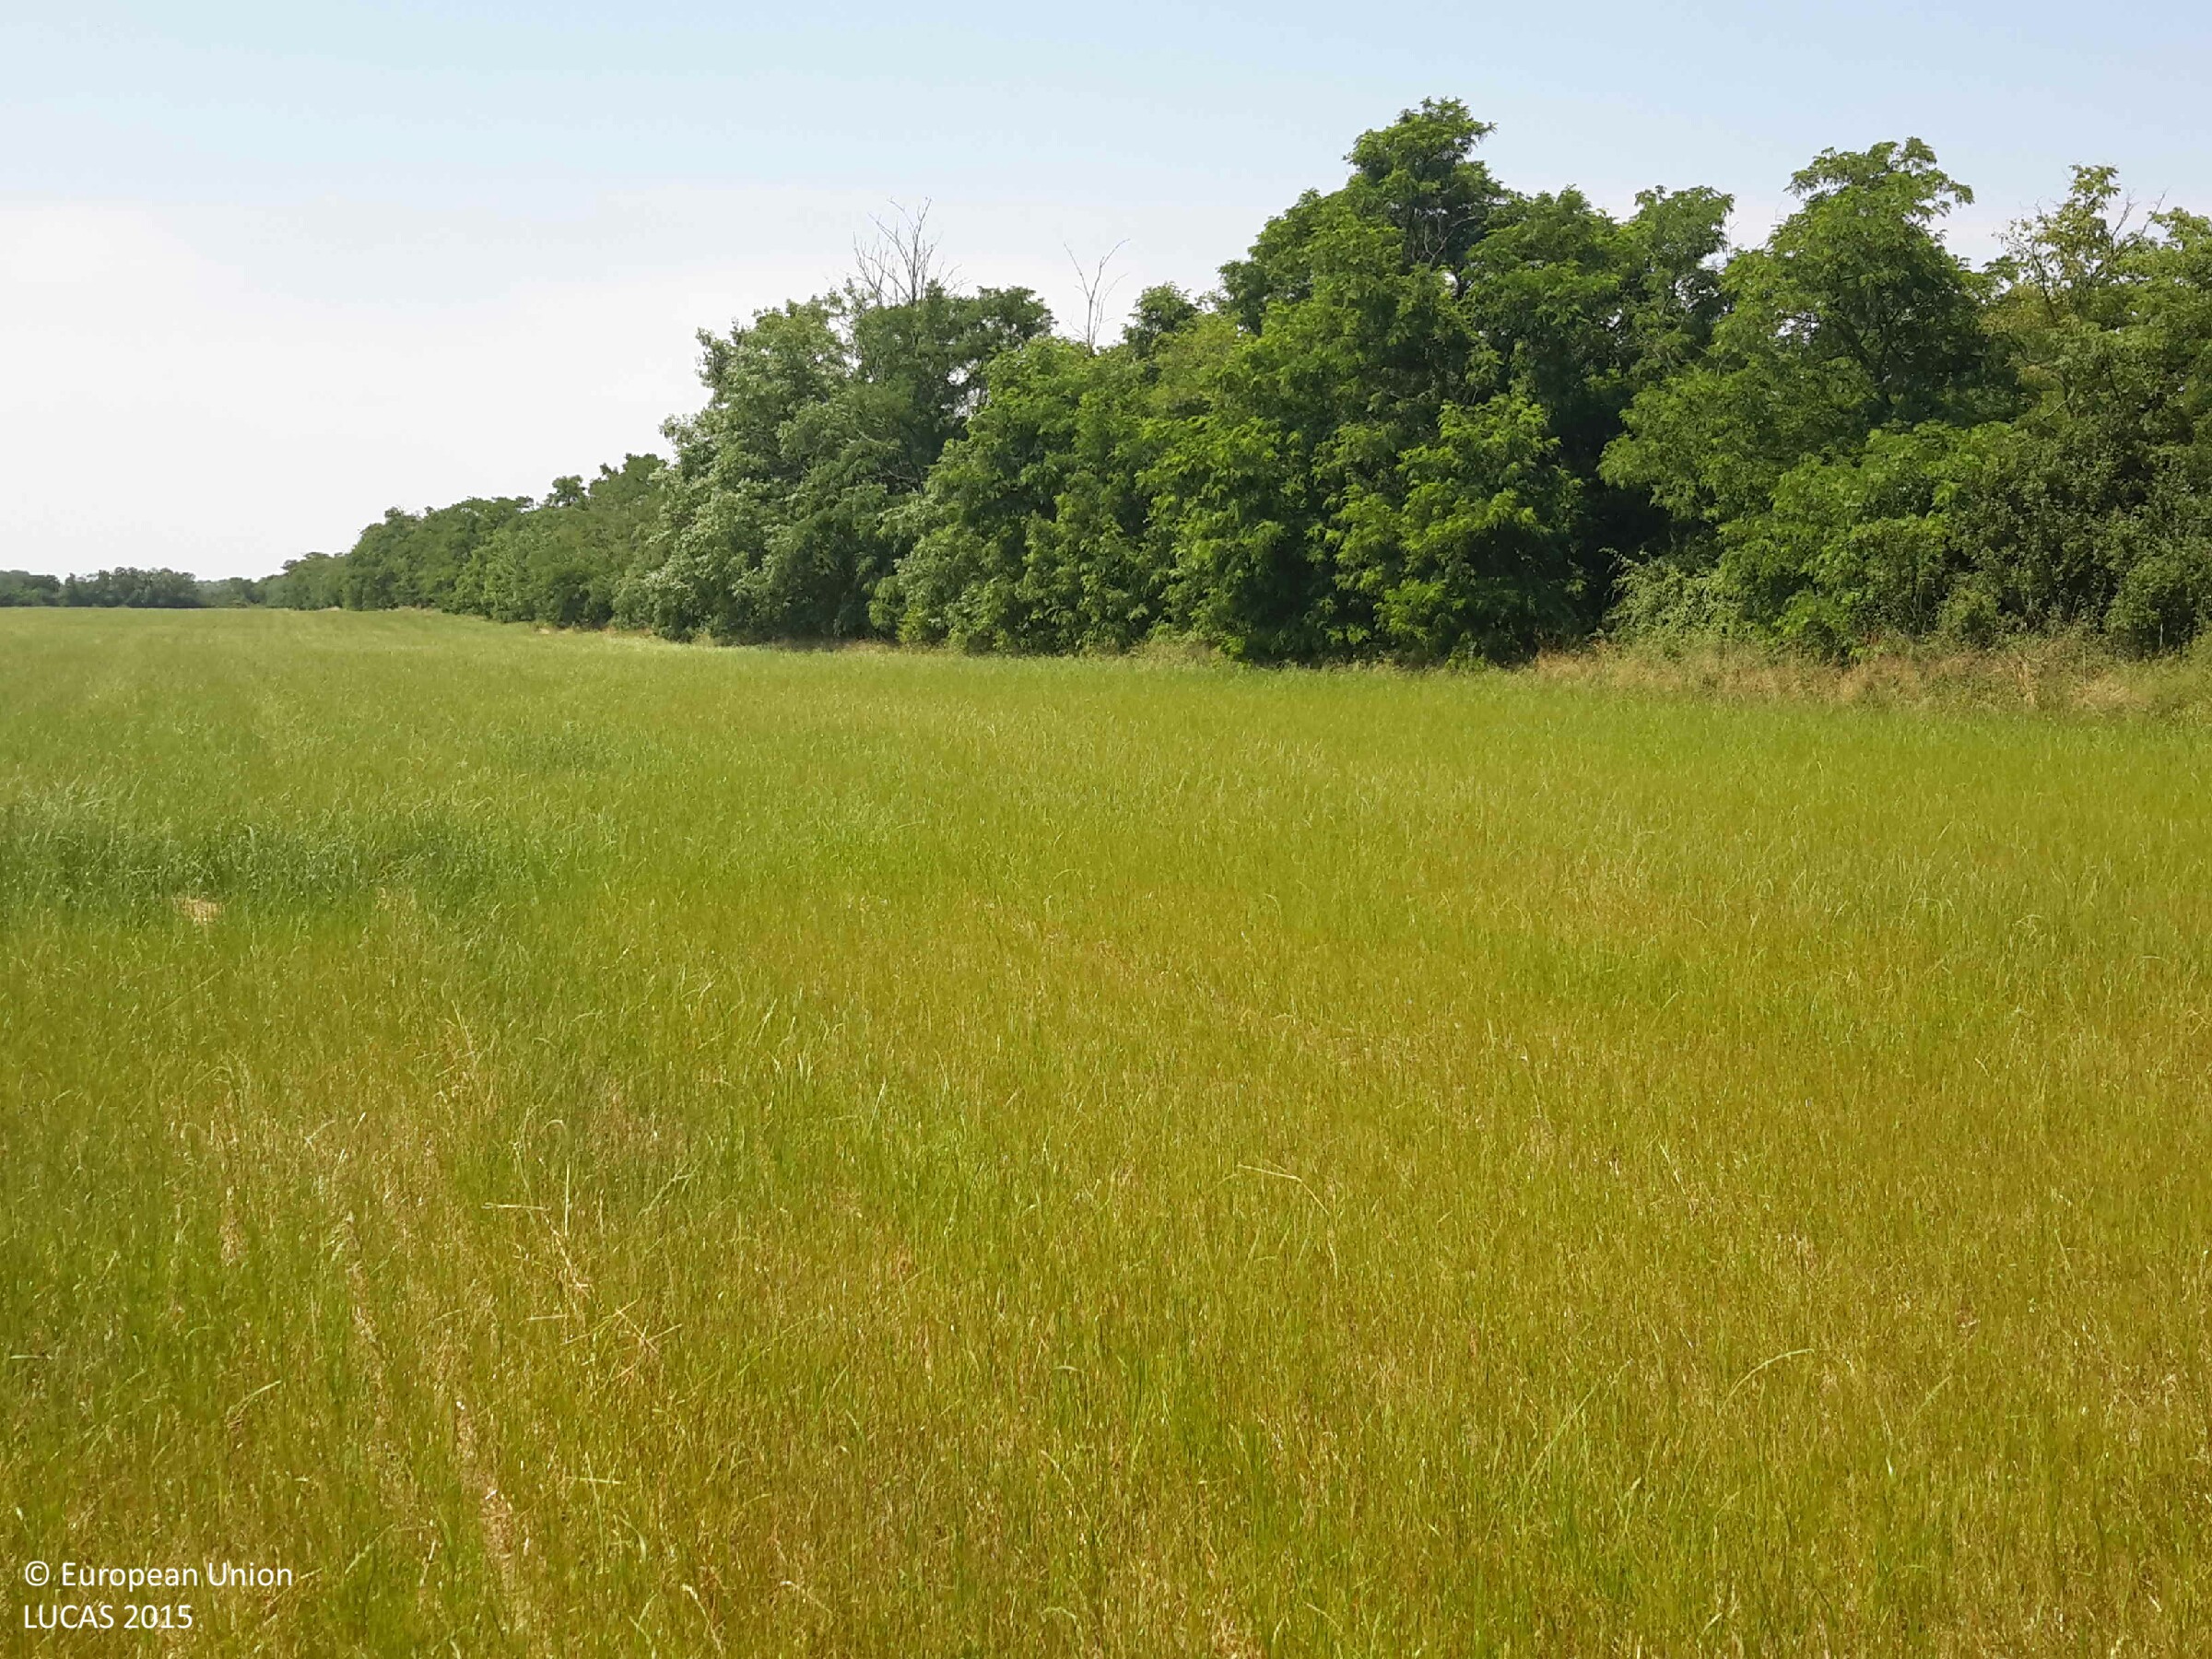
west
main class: Grassland
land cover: Grassland without tree/shrub cover
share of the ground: > 75 %
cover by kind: herbaceous plants 100 %
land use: Agriculture (excluding fallow land and kitchen gardens)
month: July
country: HU
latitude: 47.3113
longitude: 17.3217
